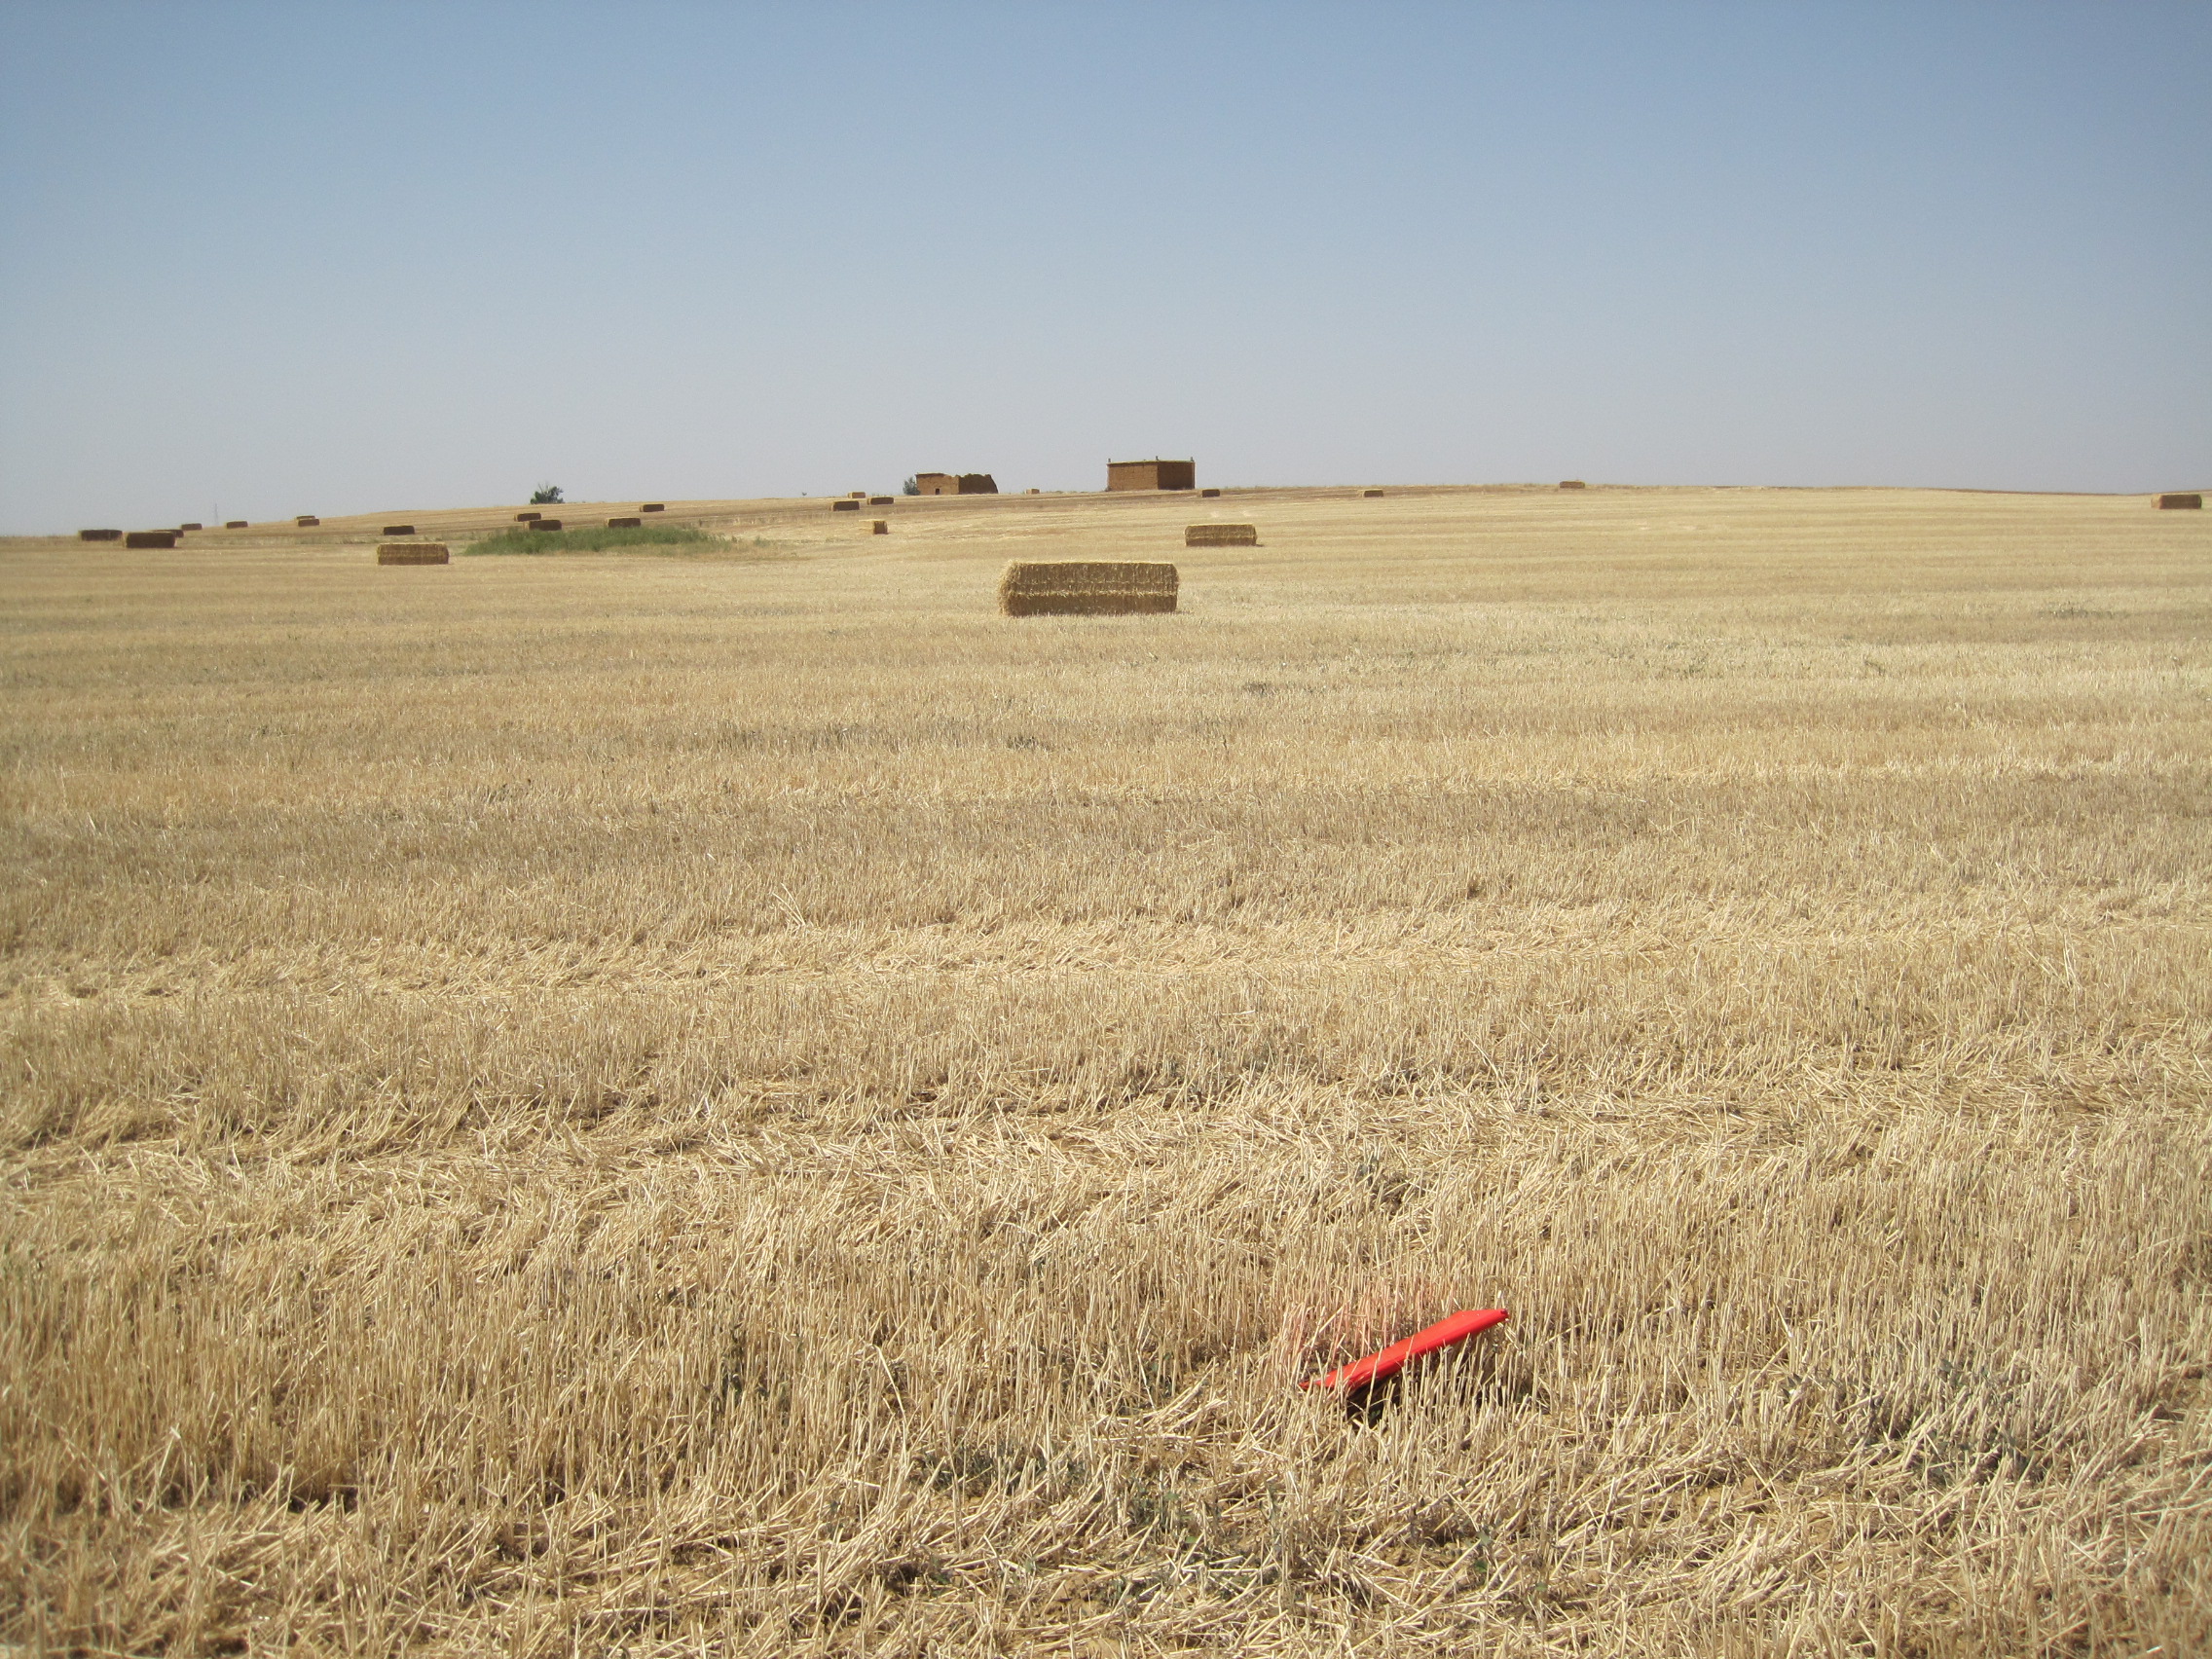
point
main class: Cropland
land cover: Barley
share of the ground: < 10 %
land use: Agriculture (excluding fallow land and kitchen gardens)
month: July
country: ES
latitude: 41.6809
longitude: -5.4475
